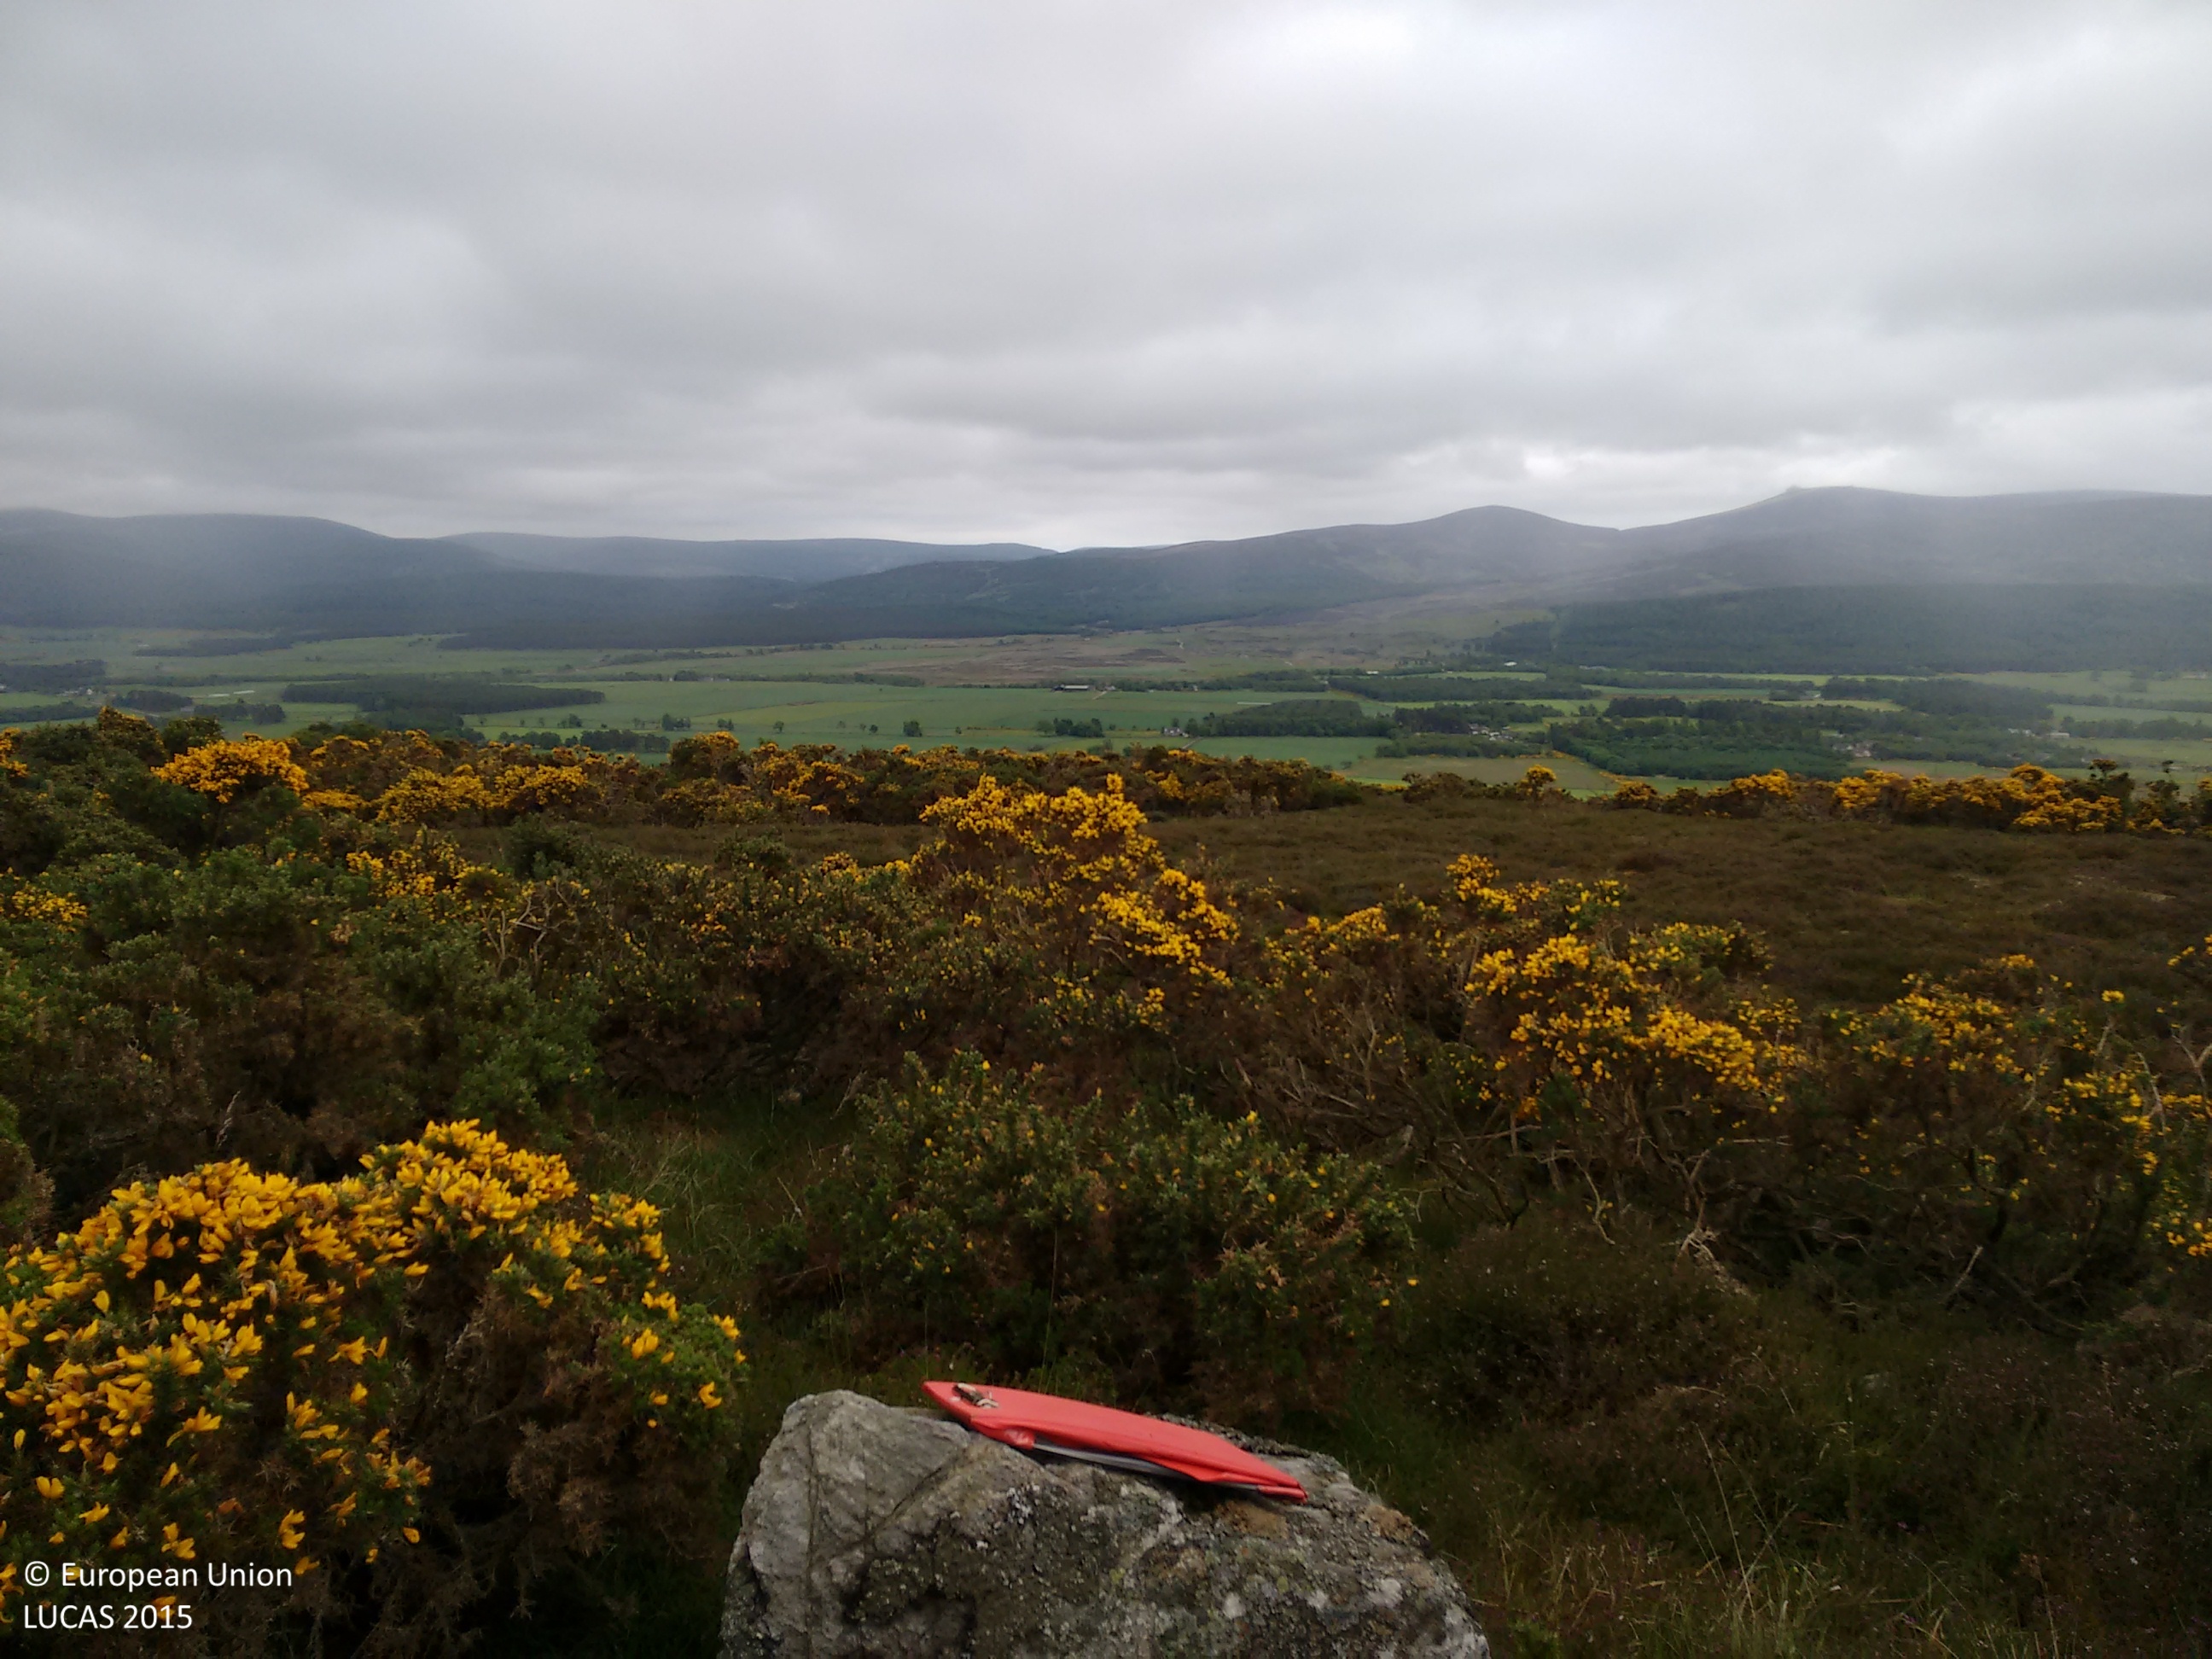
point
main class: Shrubland
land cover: Shrubland without tree cover
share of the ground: > 75 %
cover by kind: shrubs 90 %, herbaceous plants 5 %, lichens and mosses 5 %
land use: Semi-natural and natural areas not in use
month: June
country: GB
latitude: 57.0370
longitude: -2.6306
